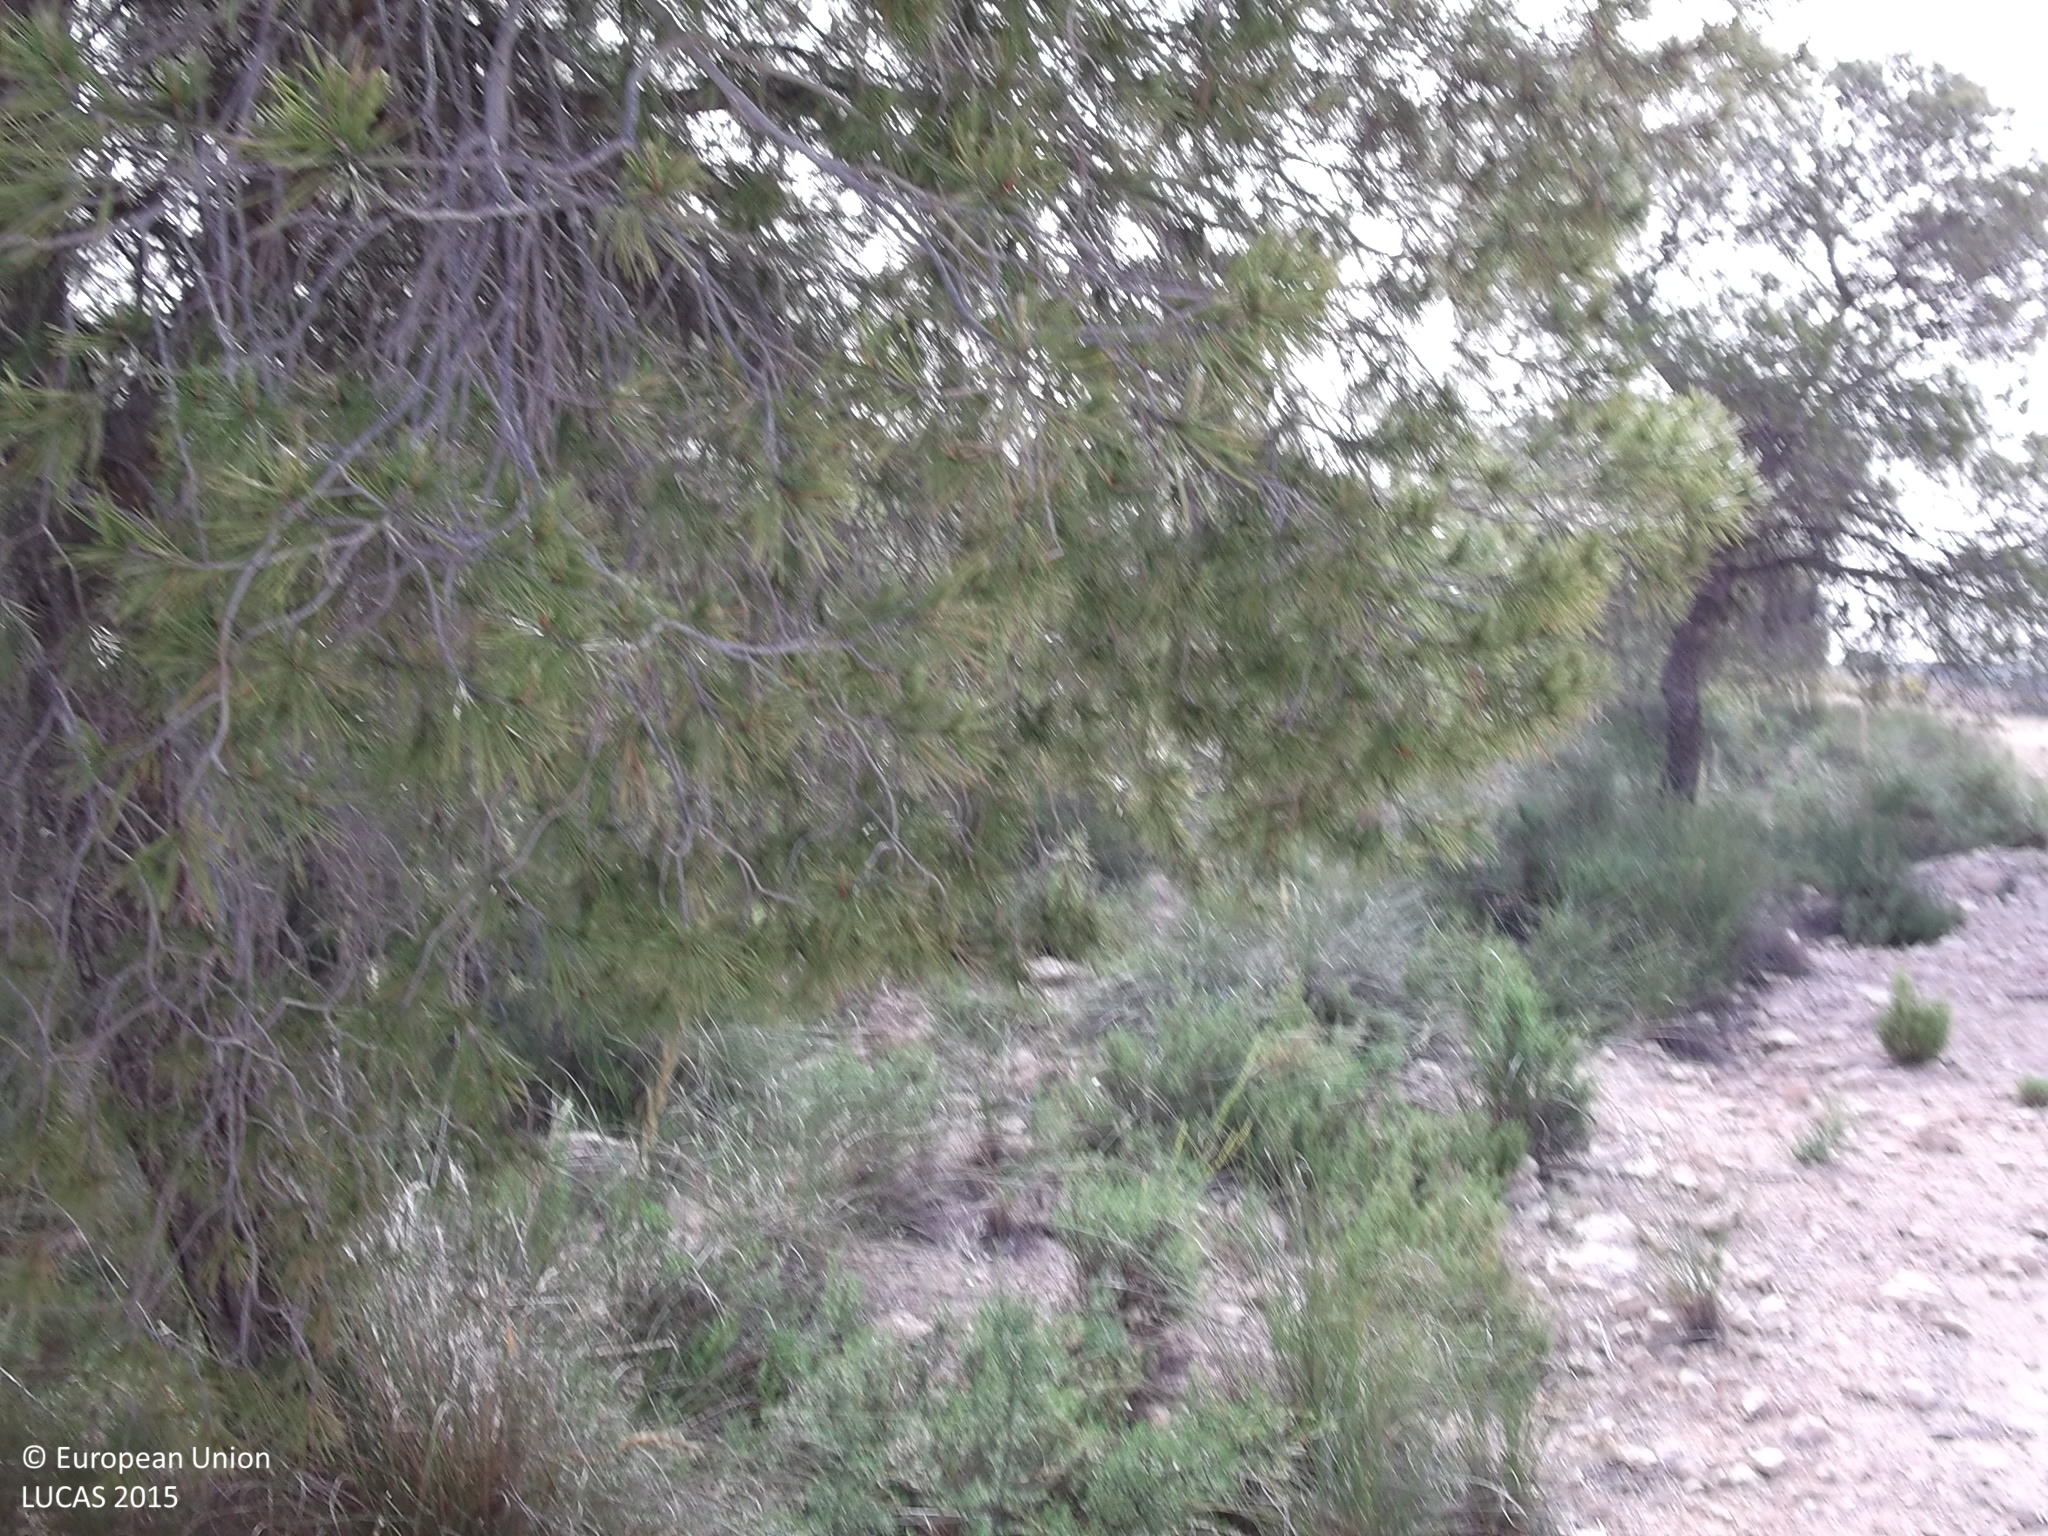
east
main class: Woodland
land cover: Pine dominated coniferous woodland
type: coniferous forest of the mediterranean region
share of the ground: 25 - 50 %
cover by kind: shrubs 40 %, coniferous forest trees 30 %, herbaceous plants 30 %
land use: Semi-natural and natural areas not in use
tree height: > 5 m
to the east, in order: Pine dominated coniferous woodland
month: May
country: ES
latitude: 38.3876
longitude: -1.6116
